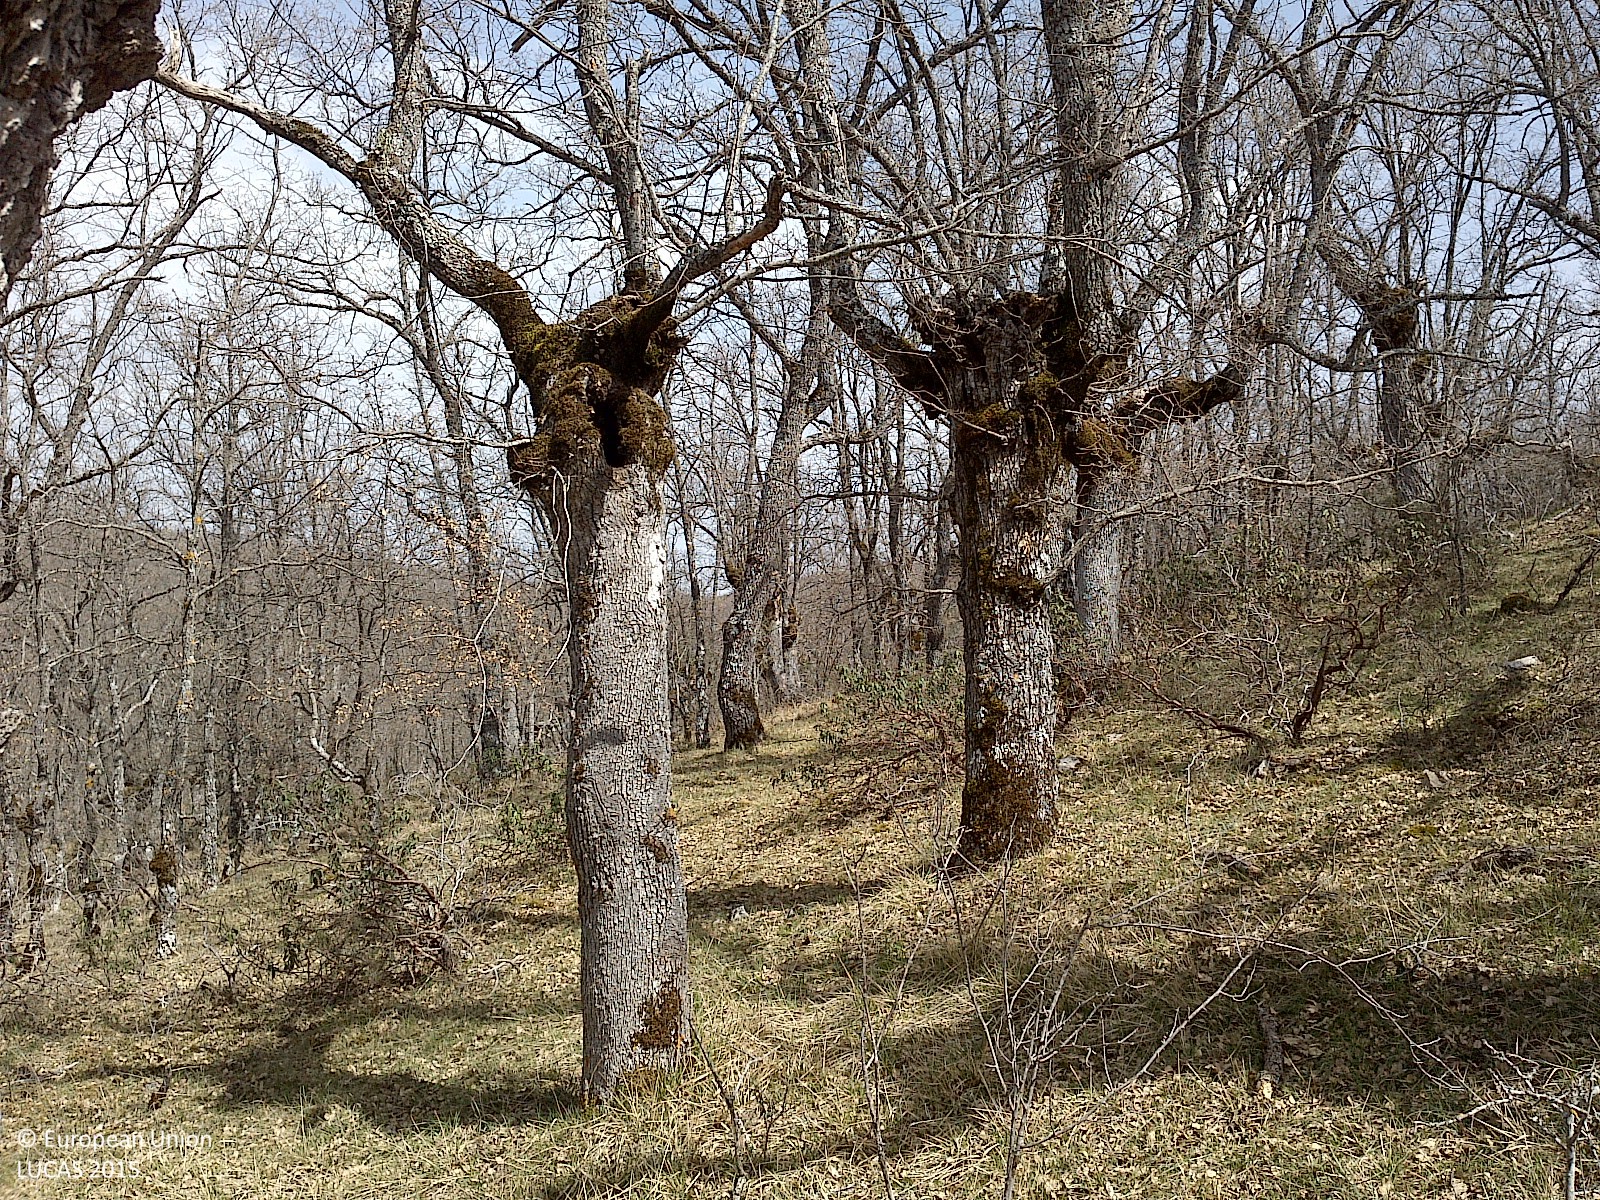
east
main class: Woodland
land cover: Broadleaved woodland
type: thermophilous deciduous forest
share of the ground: 50 - 75 %
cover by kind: broadleaved forest trees 50 %, herbaceous plants 30 %, shrubs 20 %
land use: Forestry
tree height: > 5 m
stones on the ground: 10 - 25 %
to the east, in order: Broadleaved woodland
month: April
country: ES
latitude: 42.0962
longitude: -3.3406
